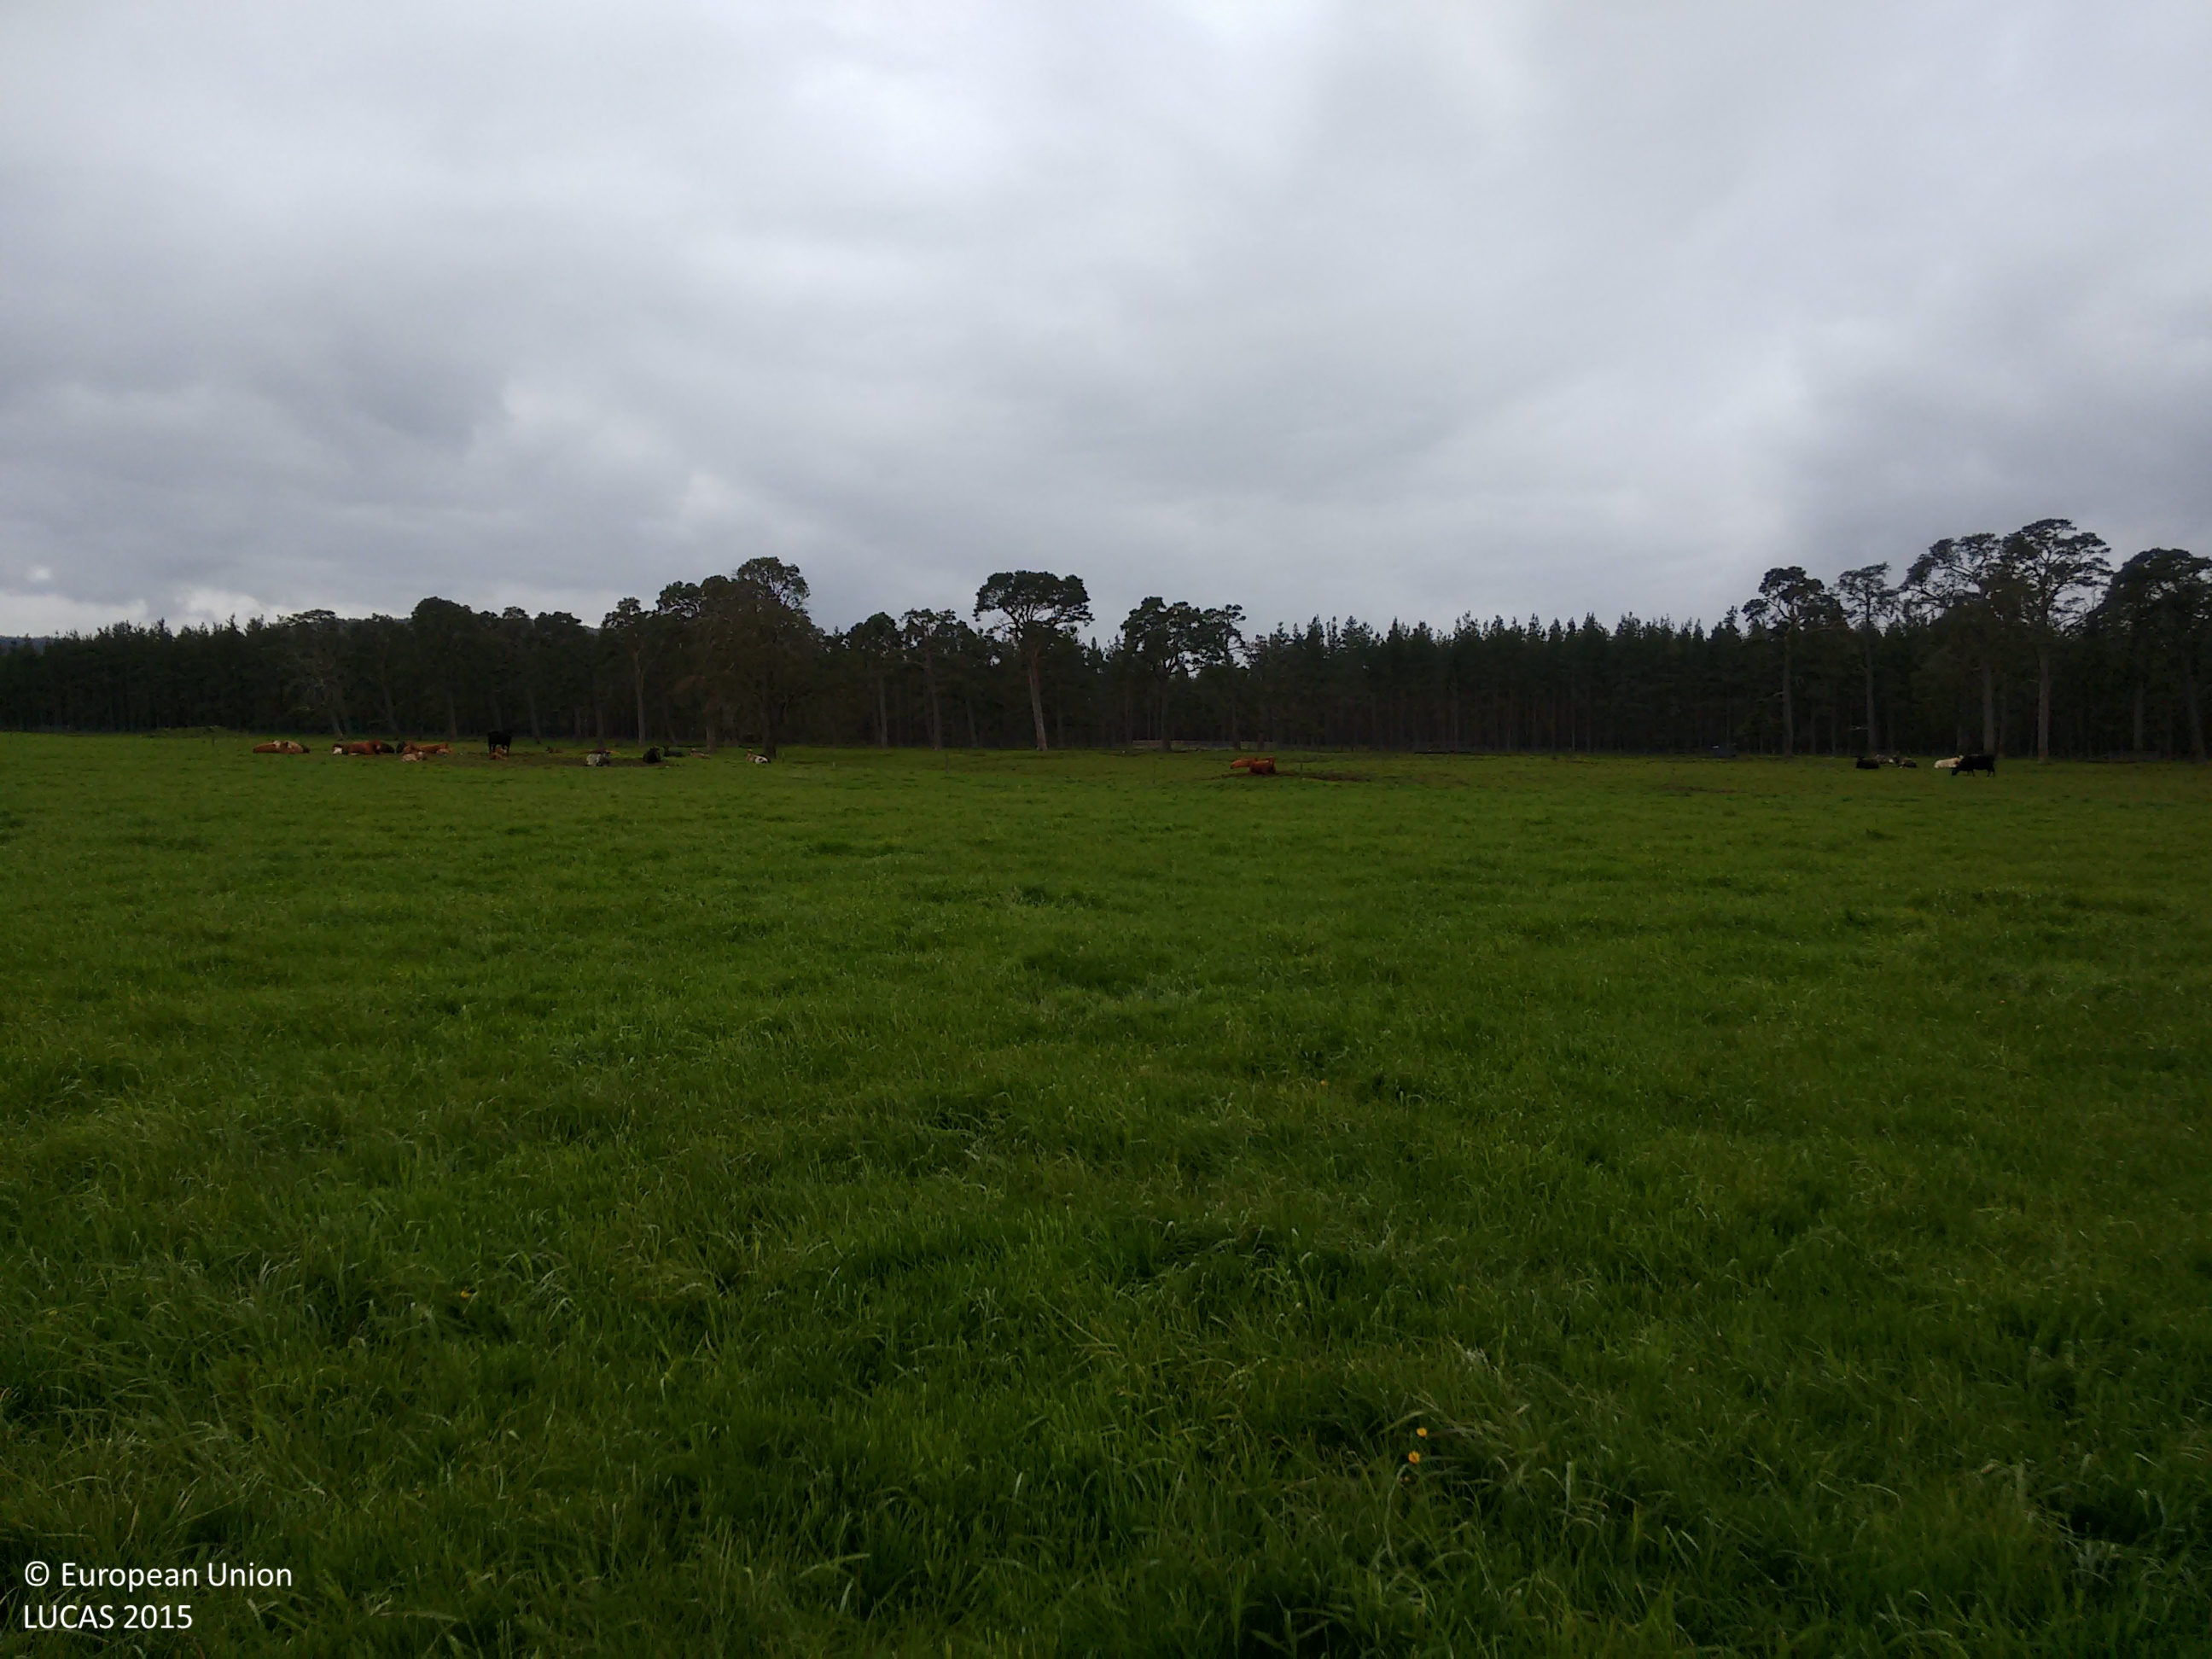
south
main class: Grassland
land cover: Grassland without tree/shrub cover
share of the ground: > 75 %
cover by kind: herbaceous plants 100 %
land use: Agriculture (excluding fallow land and kitchen gardens)
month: June
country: GB
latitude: 57.2837
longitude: -3.7965
